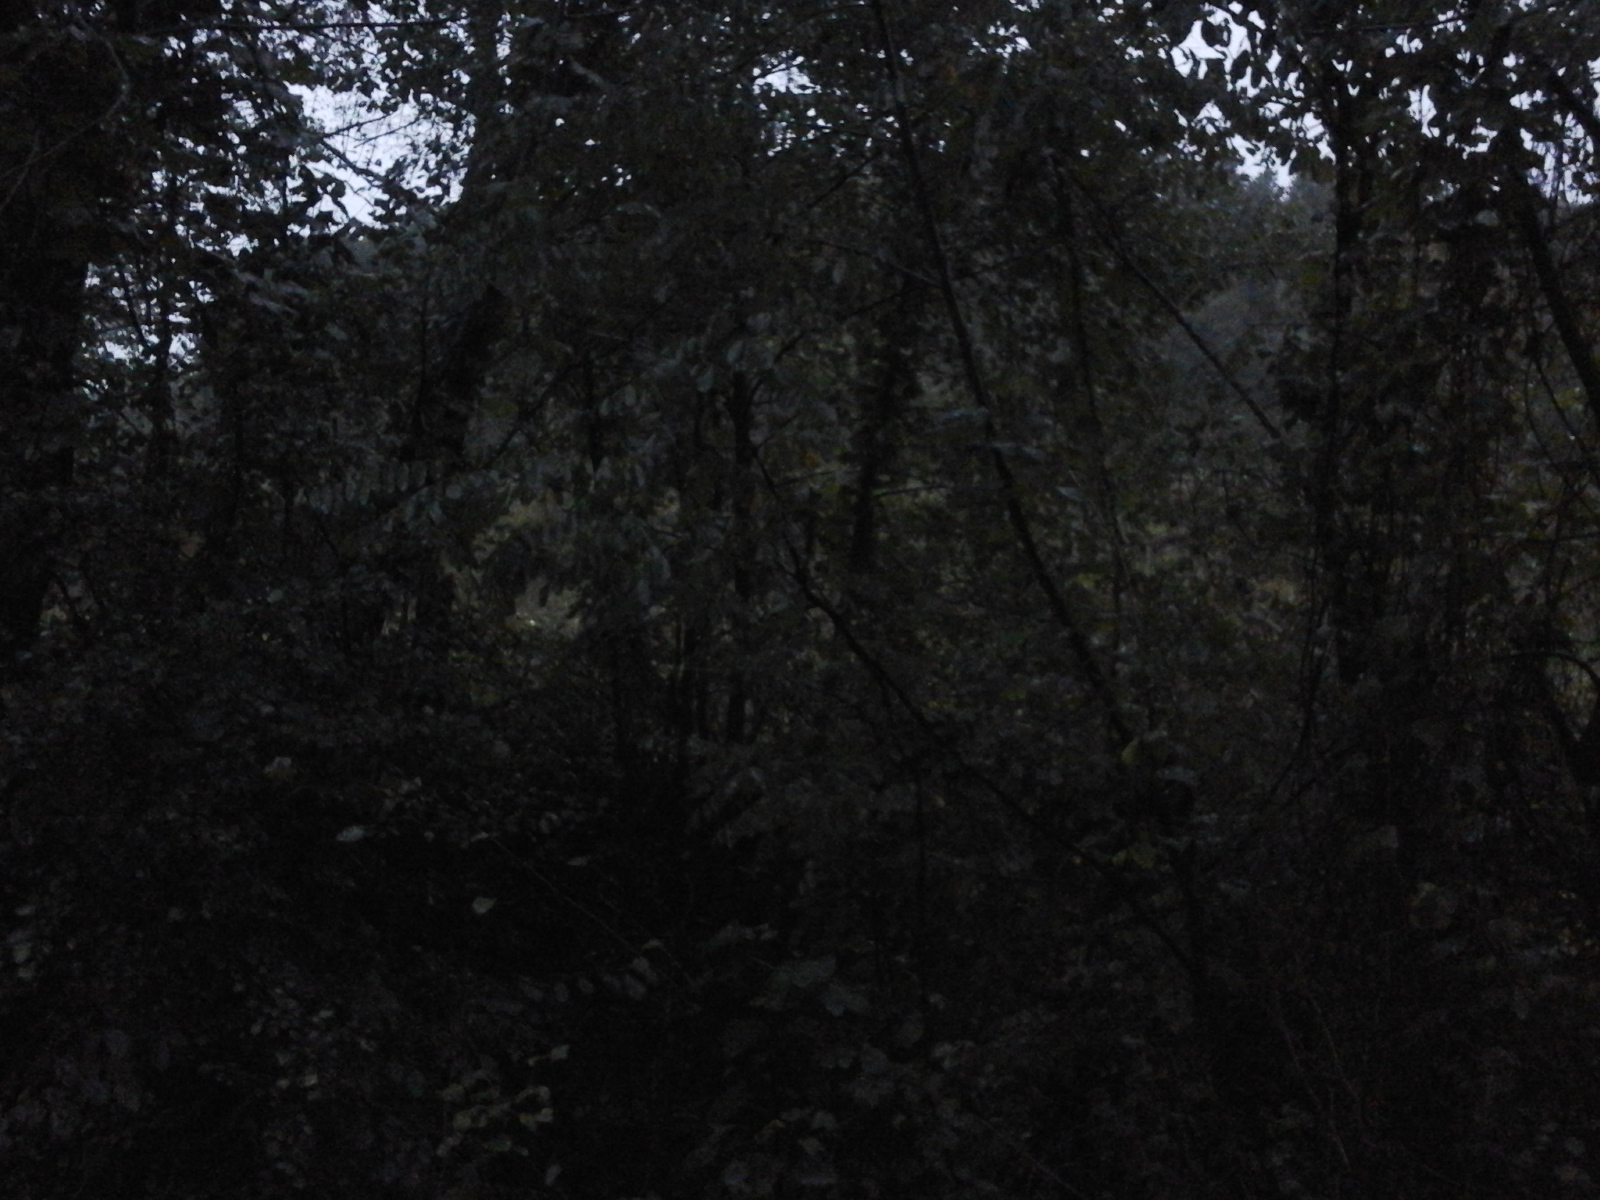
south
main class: Woodland
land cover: Broadleaved woodland
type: beech forest
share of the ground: > 75 %
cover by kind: broadleaved forest trees 100 %
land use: Forestry
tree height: > 5 m
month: September
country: RO
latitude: 44.9617
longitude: 23.6368
